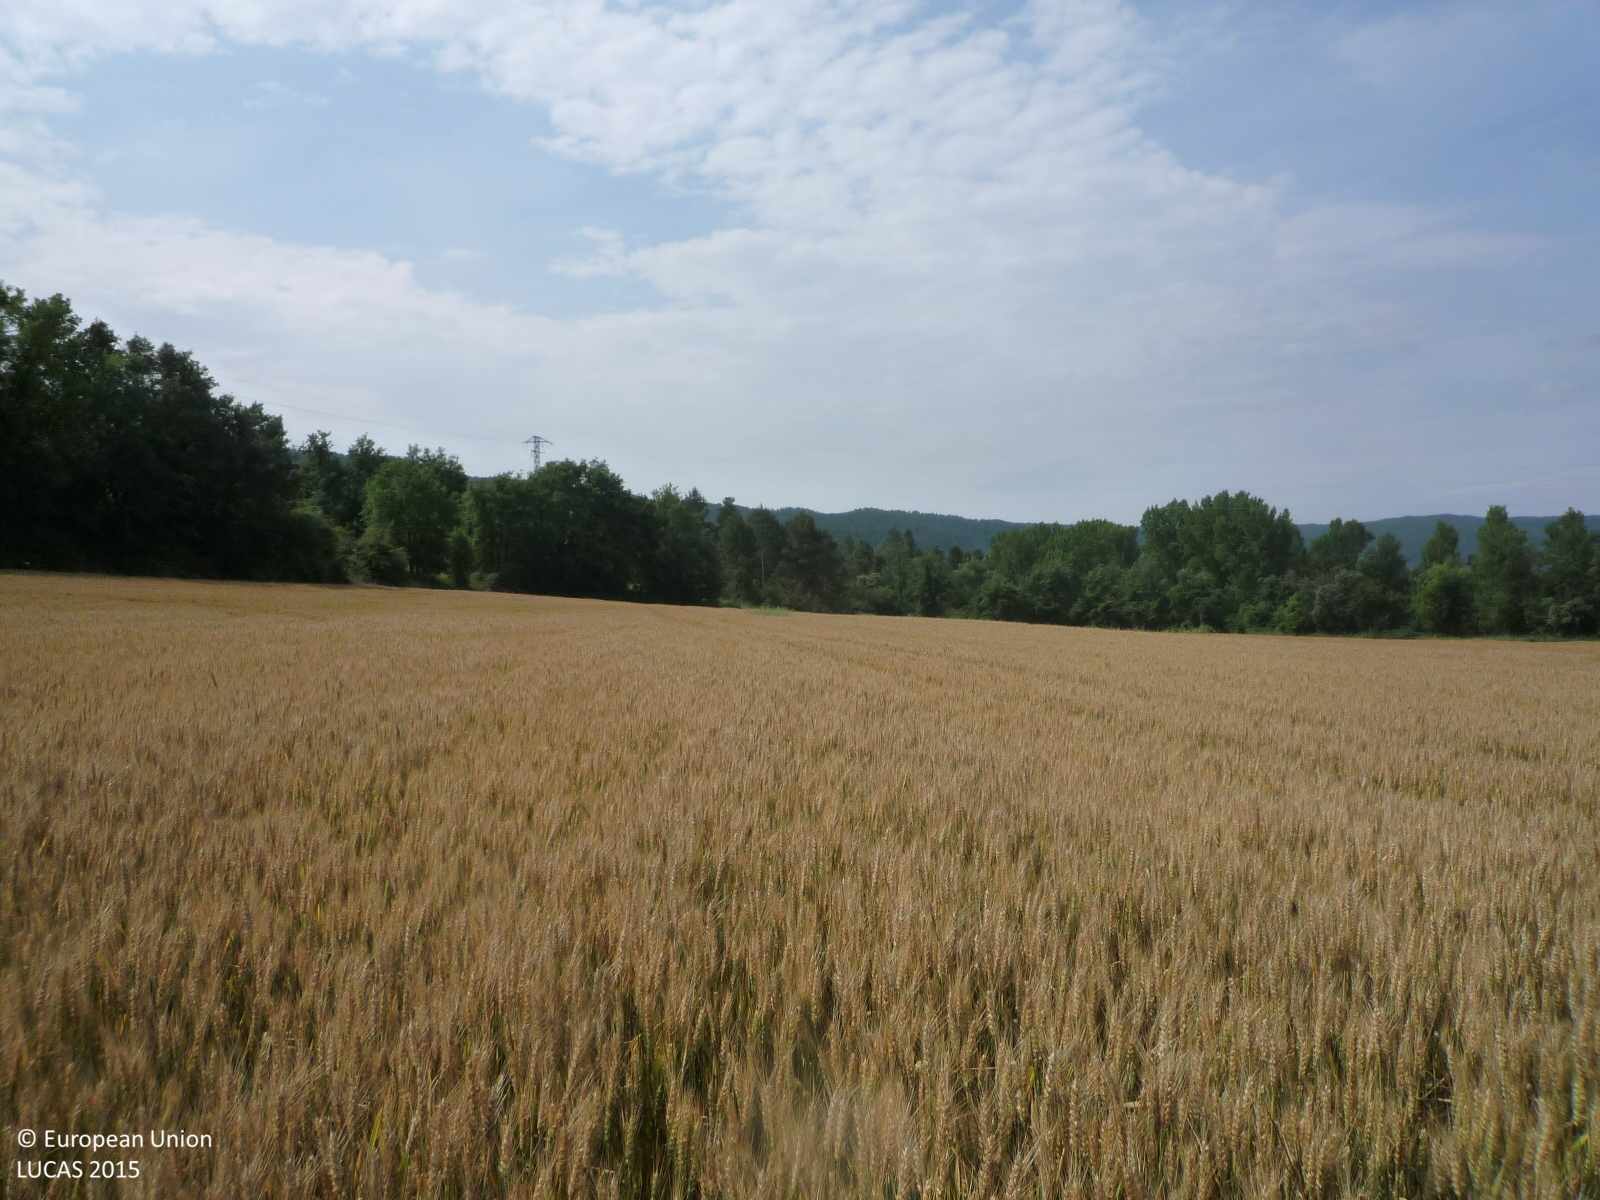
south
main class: Cropland
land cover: Durum wheat
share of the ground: > 75 %
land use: Agriculture (excluding fallow land and kitchen gardens)
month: June
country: ES
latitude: 42.0094
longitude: 1.9842
